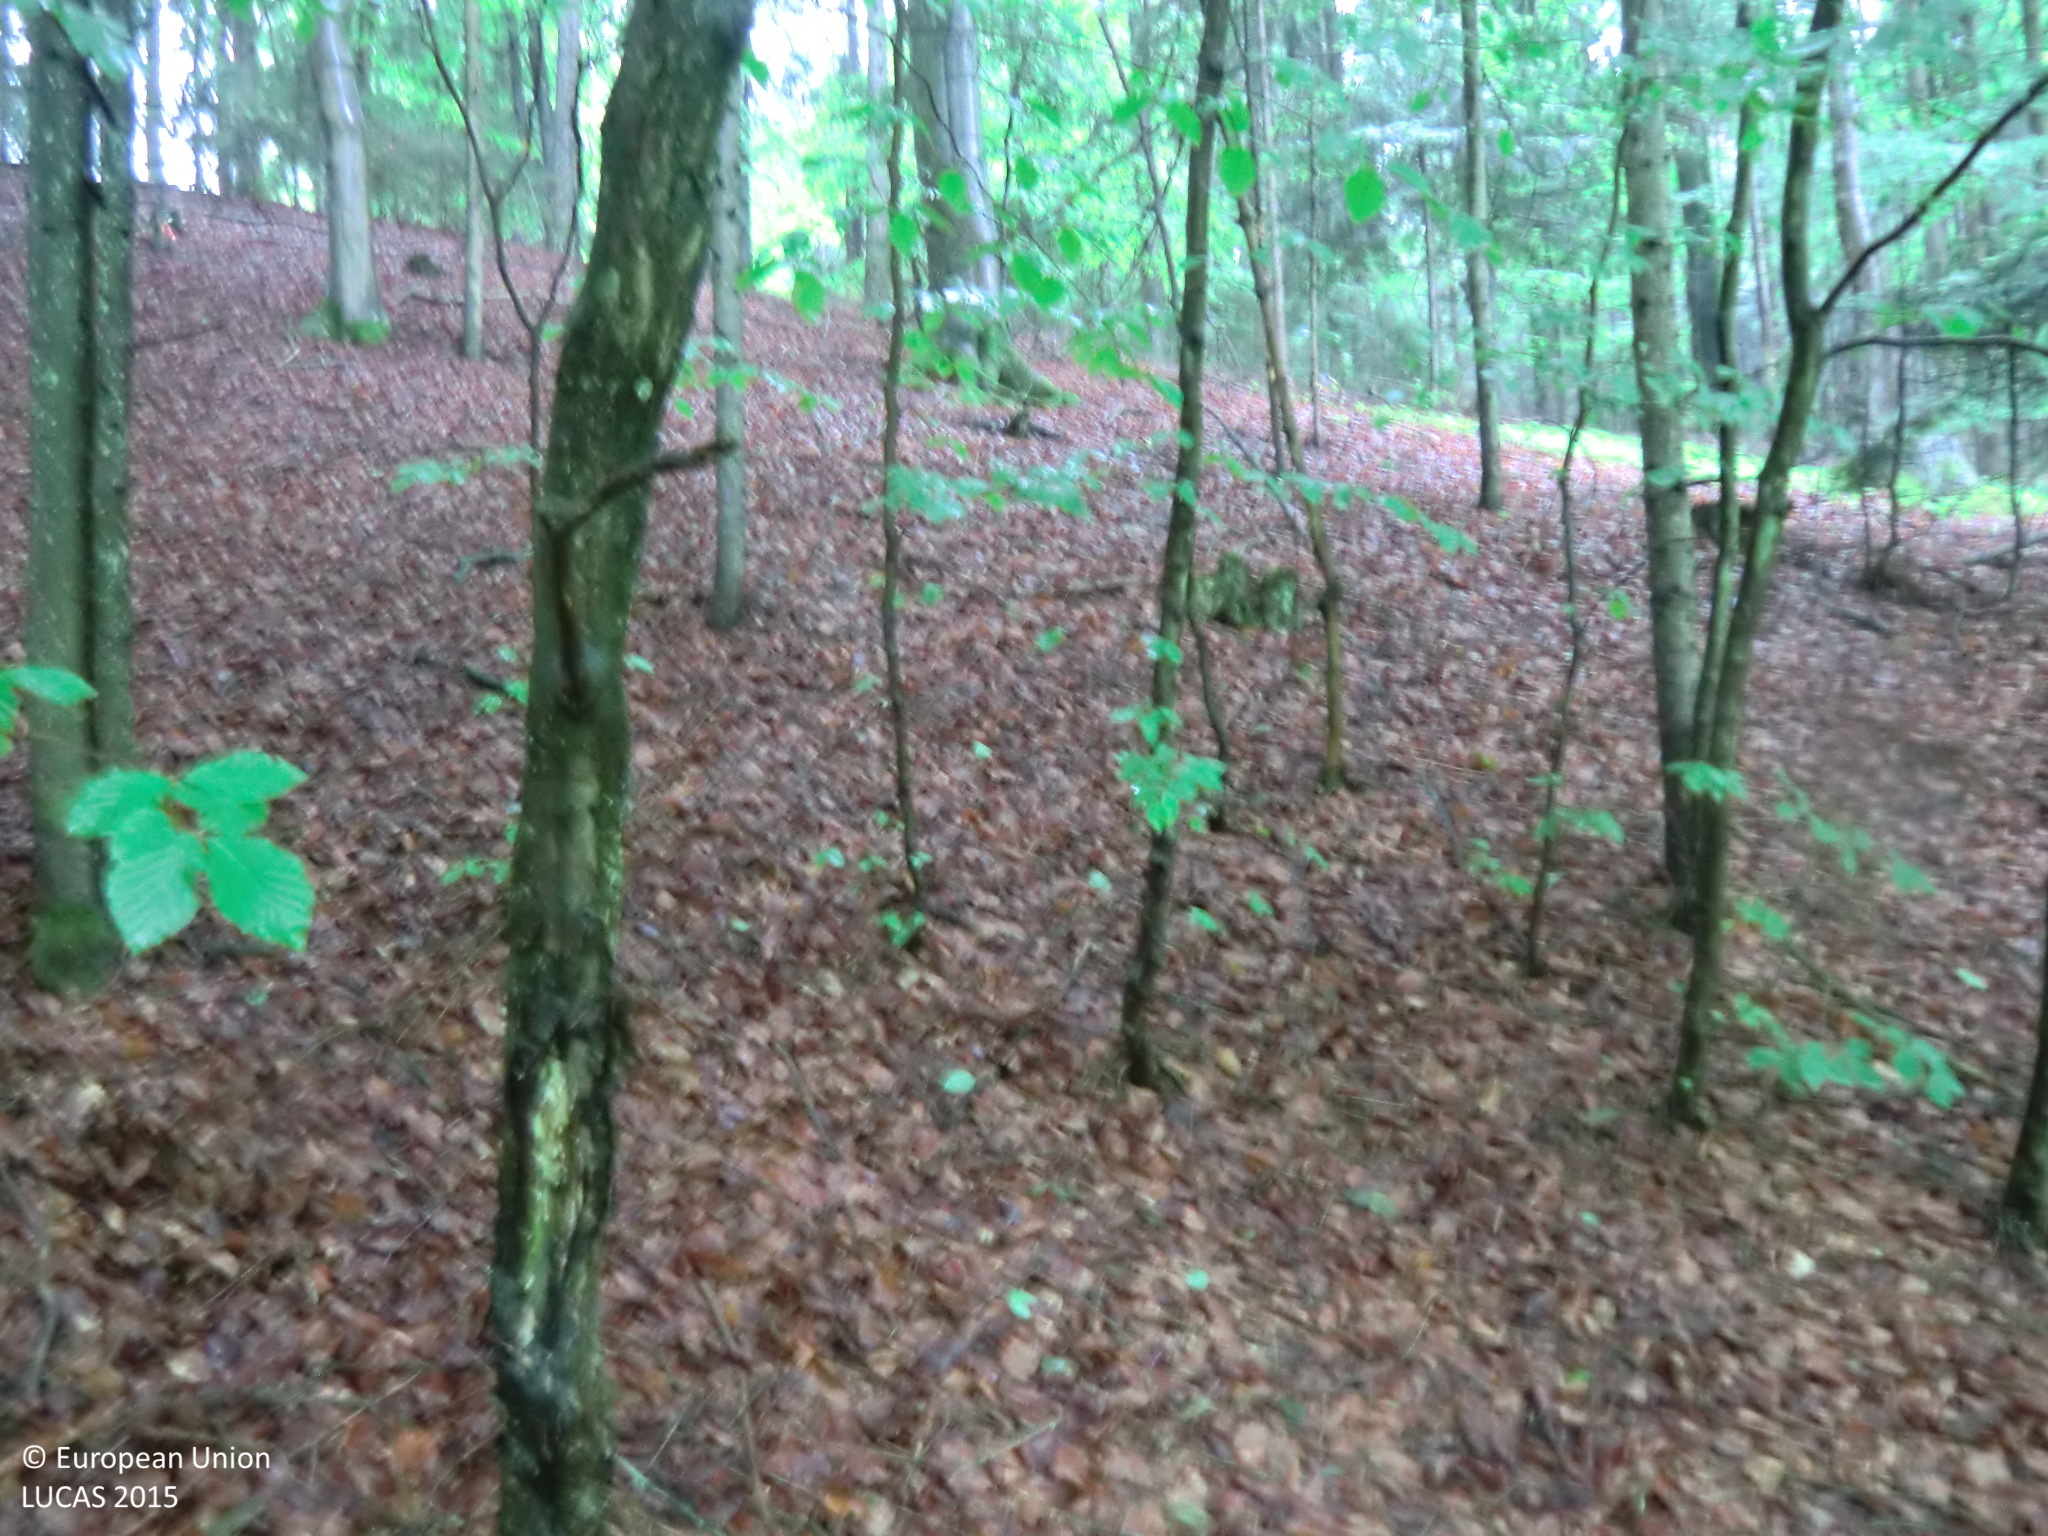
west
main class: Woodland
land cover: Spruce dominated mixed woodland
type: hemiboreal forest and nemoral coniferous forest and mixed broadleaved-coniferous forest
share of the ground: > 75 %
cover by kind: broadleaved forest trees 45 %, coniferous forest trees 40 %, unconsolidated bare surface 15 %
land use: Forestry
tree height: > 5 m
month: May
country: AT
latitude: 48.3942
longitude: 14.6873
